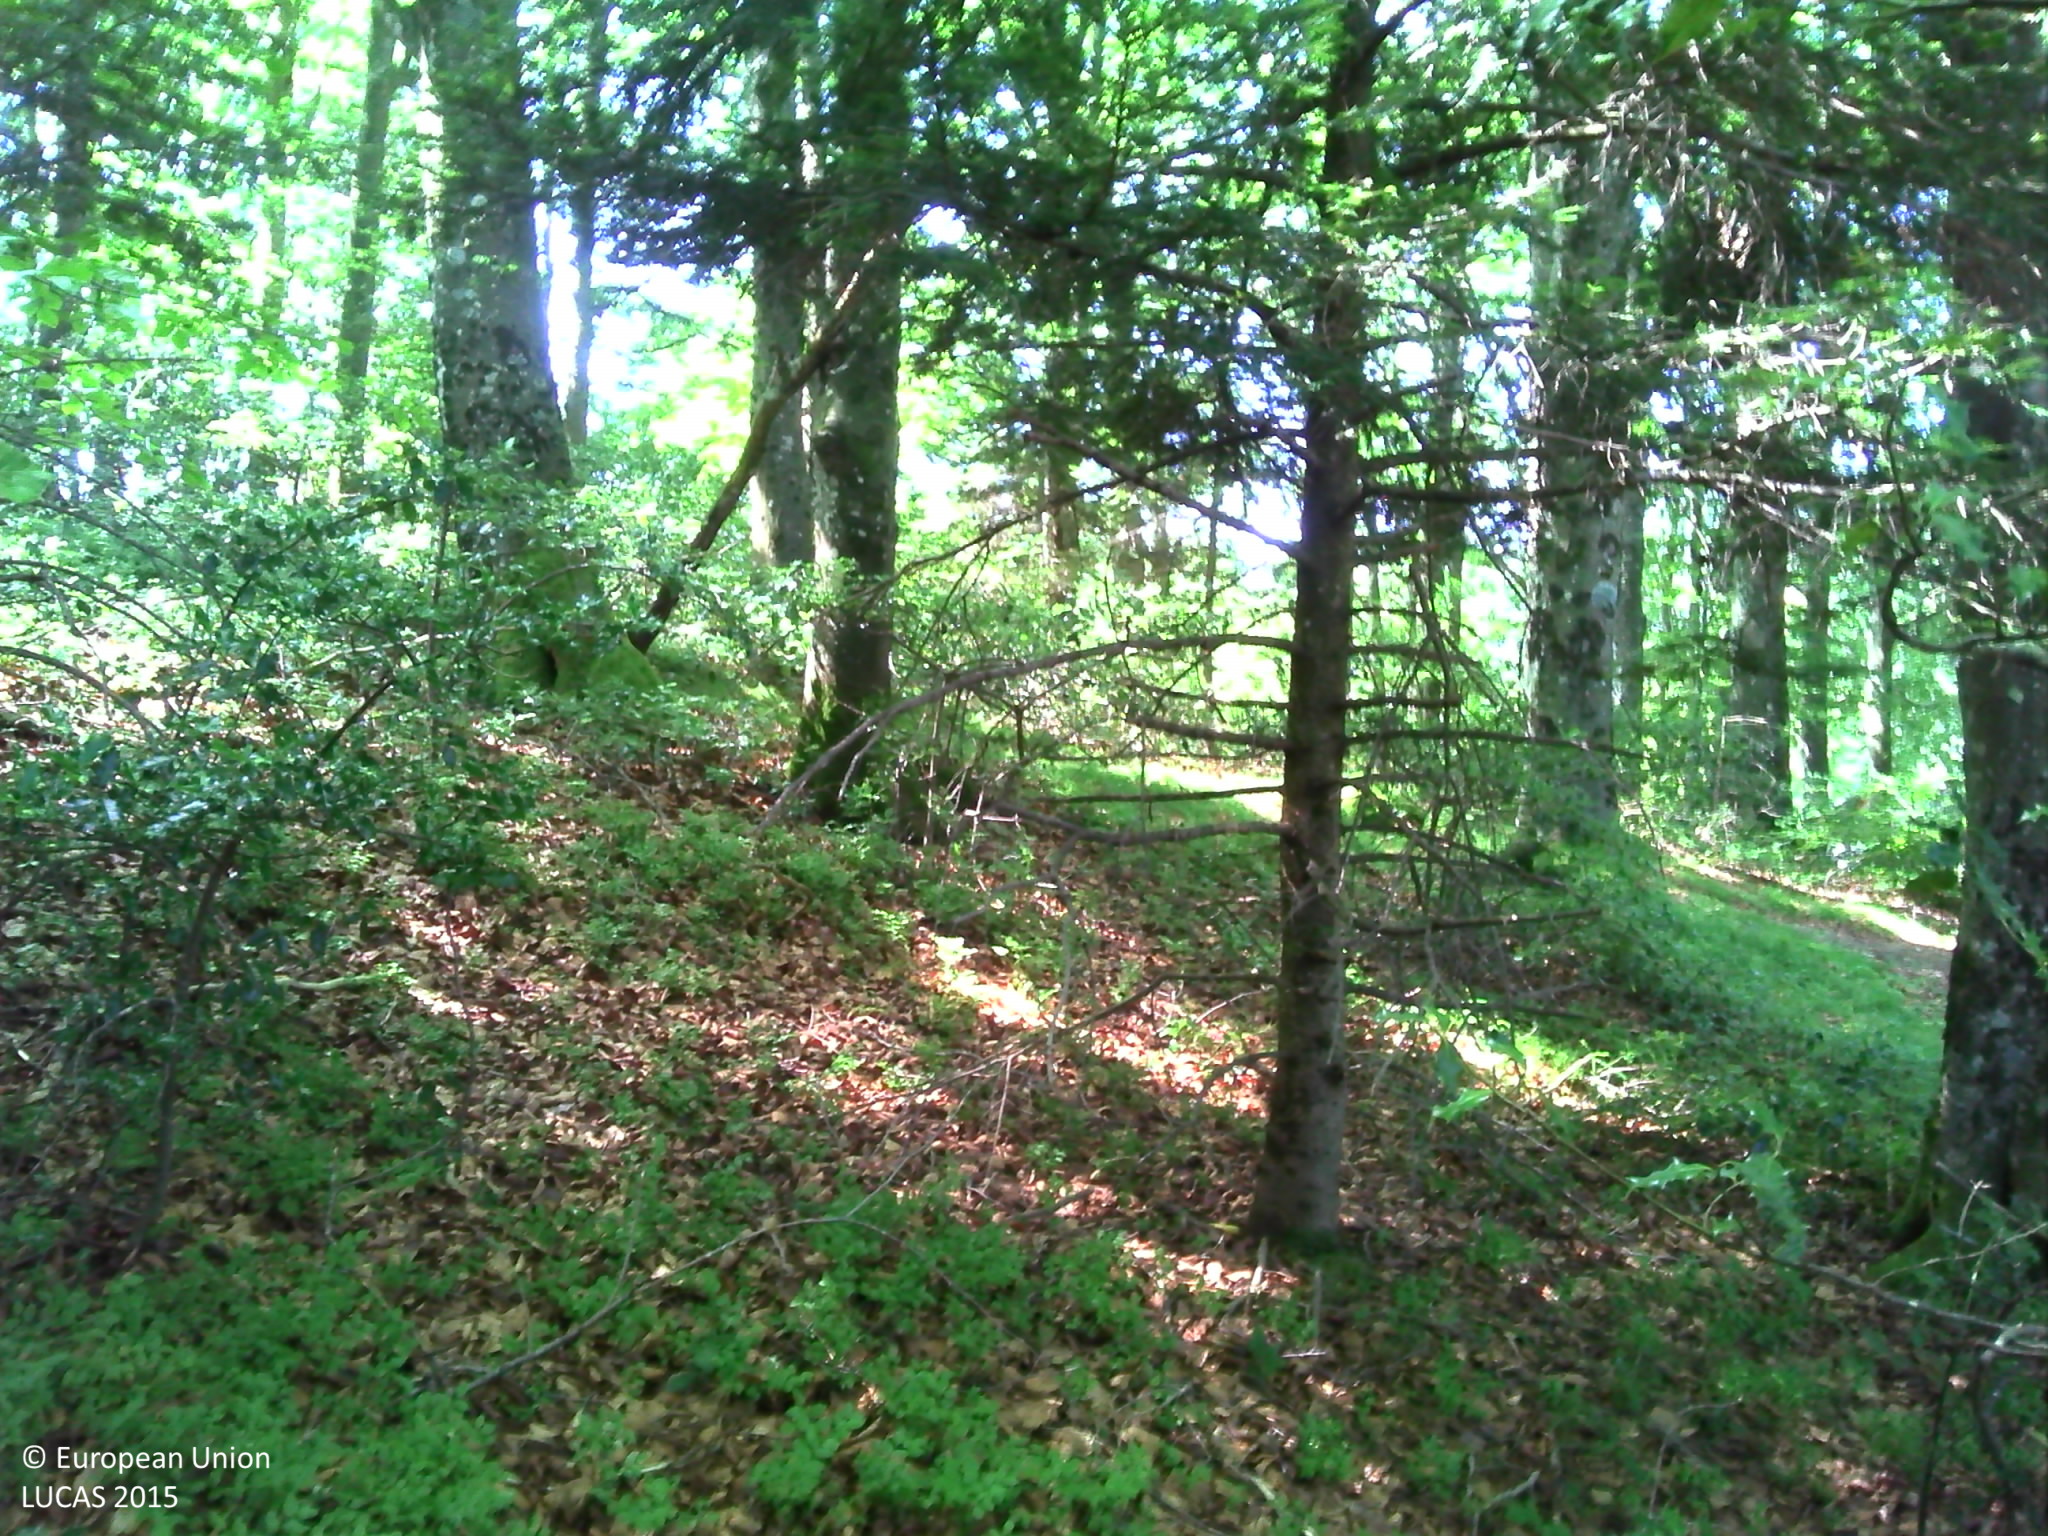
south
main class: Woodland
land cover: Spruce dominated mixed woodland
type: mountainous beech forest
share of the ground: > 75 %
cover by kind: broadleaved forest trees 55 %, coniferous forest trees 20 %, unconsolidated bare surface 15 %, herbaceous plants 10 %
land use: Forestry
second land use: Sport
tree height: > 5 m
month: August
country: FR
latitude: 42.9623
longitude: 1.4370
